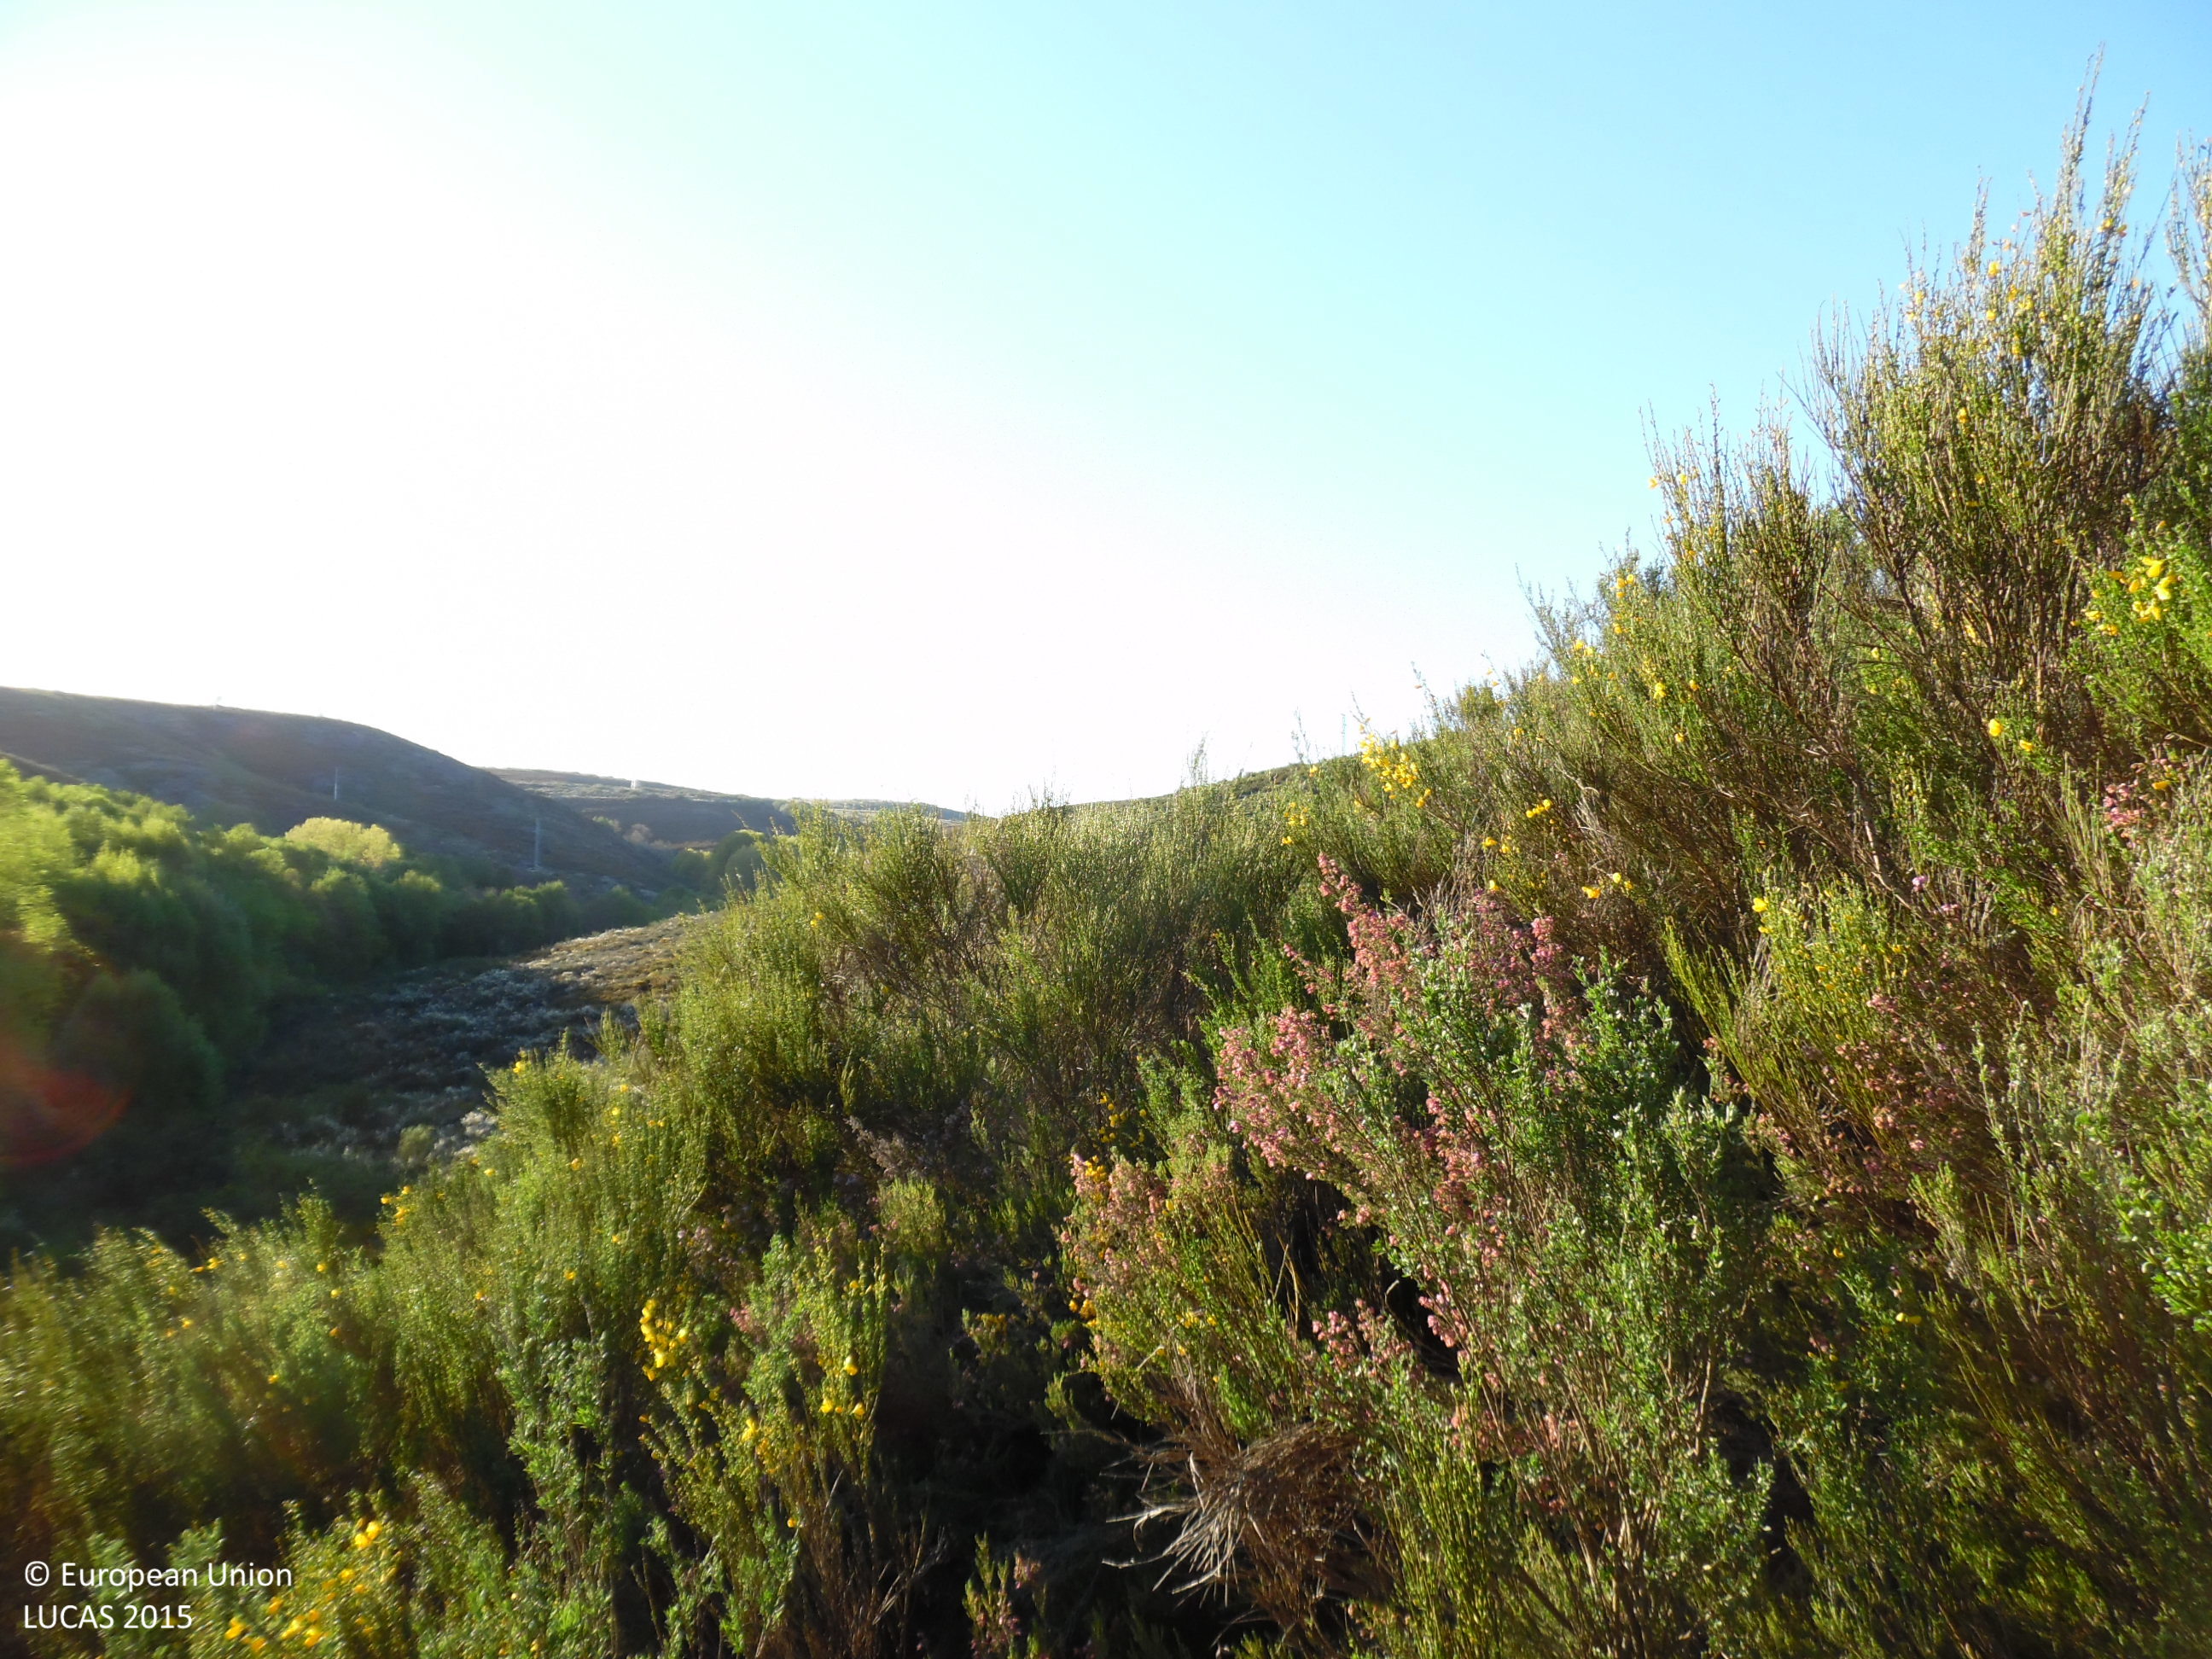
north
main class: Shrubland
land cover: Shrubland without tree cover
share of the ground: > 75 %
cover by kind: shrubs 100 %
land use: Semi-natural and natural areas not in use
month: May
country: ES
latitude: 42.6779
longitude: -6.1082
